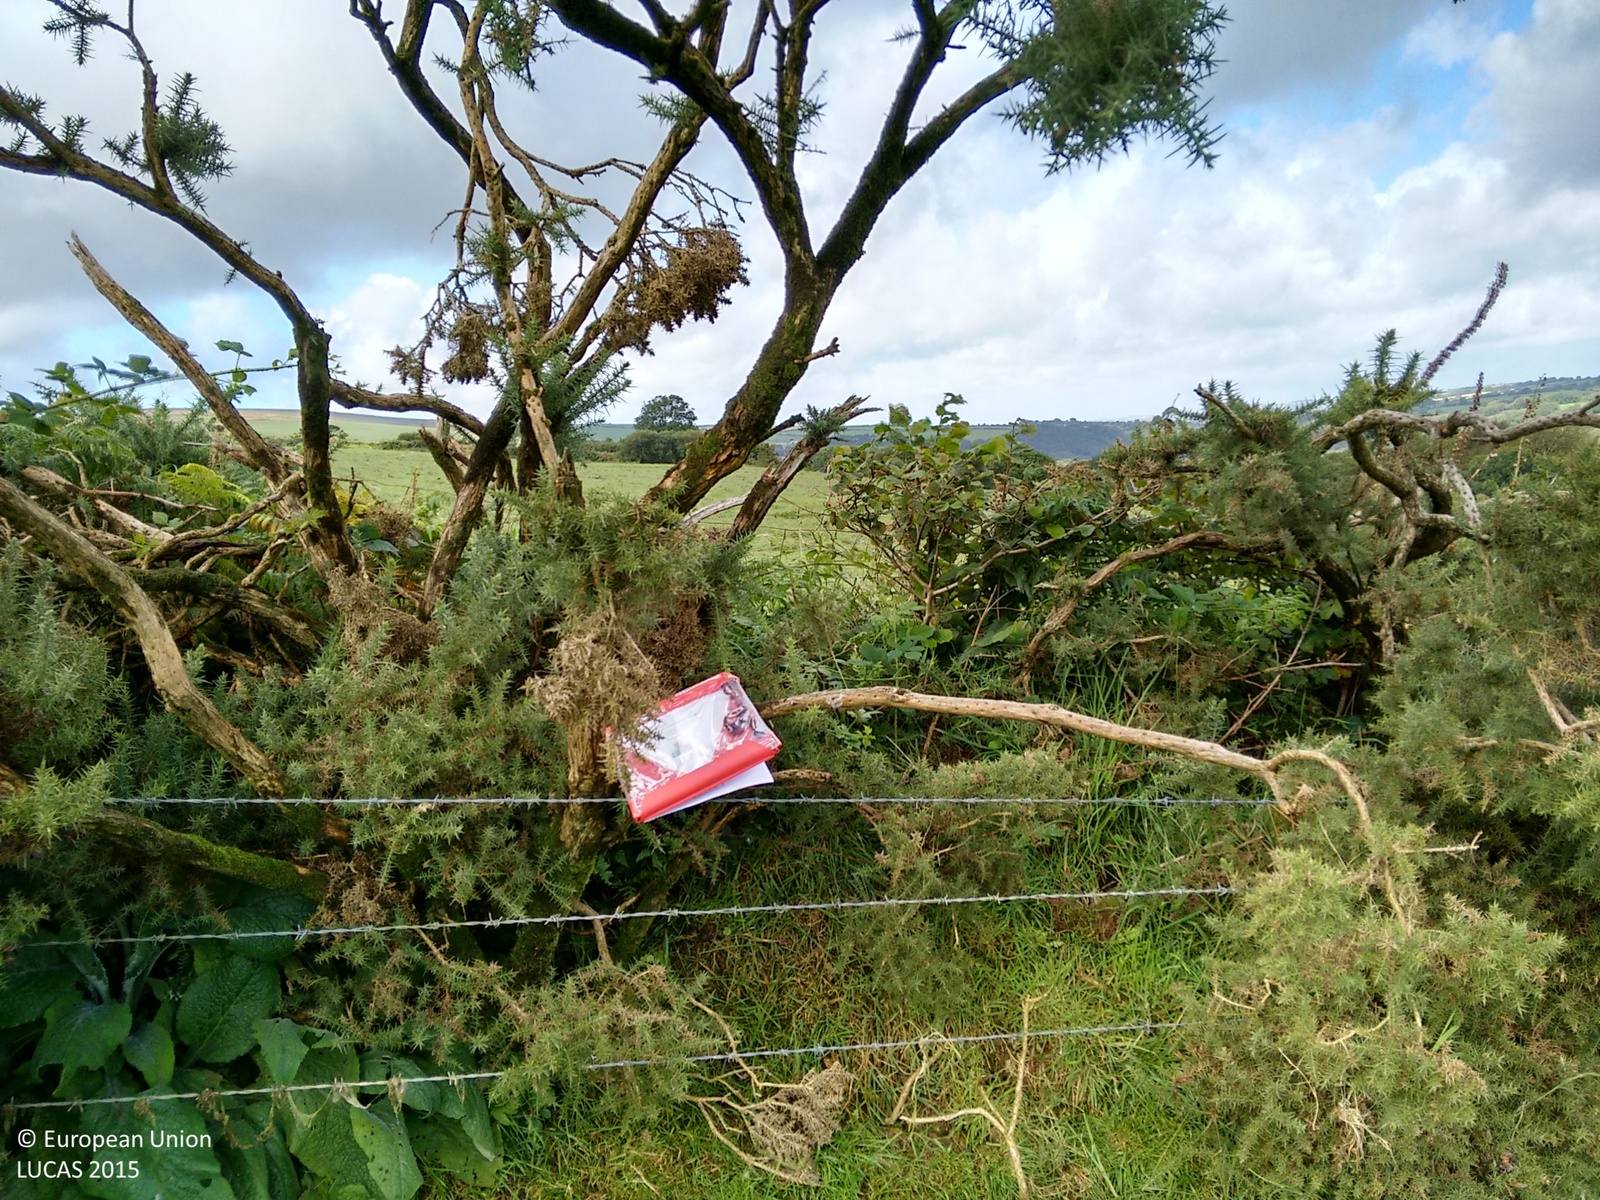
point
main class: Grassland
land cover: Grassland without tree/shrub cover
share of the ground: > 75 %
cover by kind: herbaceous plants 100 %
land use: Agriculture (excluding fallow land and kitchen gardens)
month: August
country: GB
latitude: 51.9658
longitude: -4.8577
